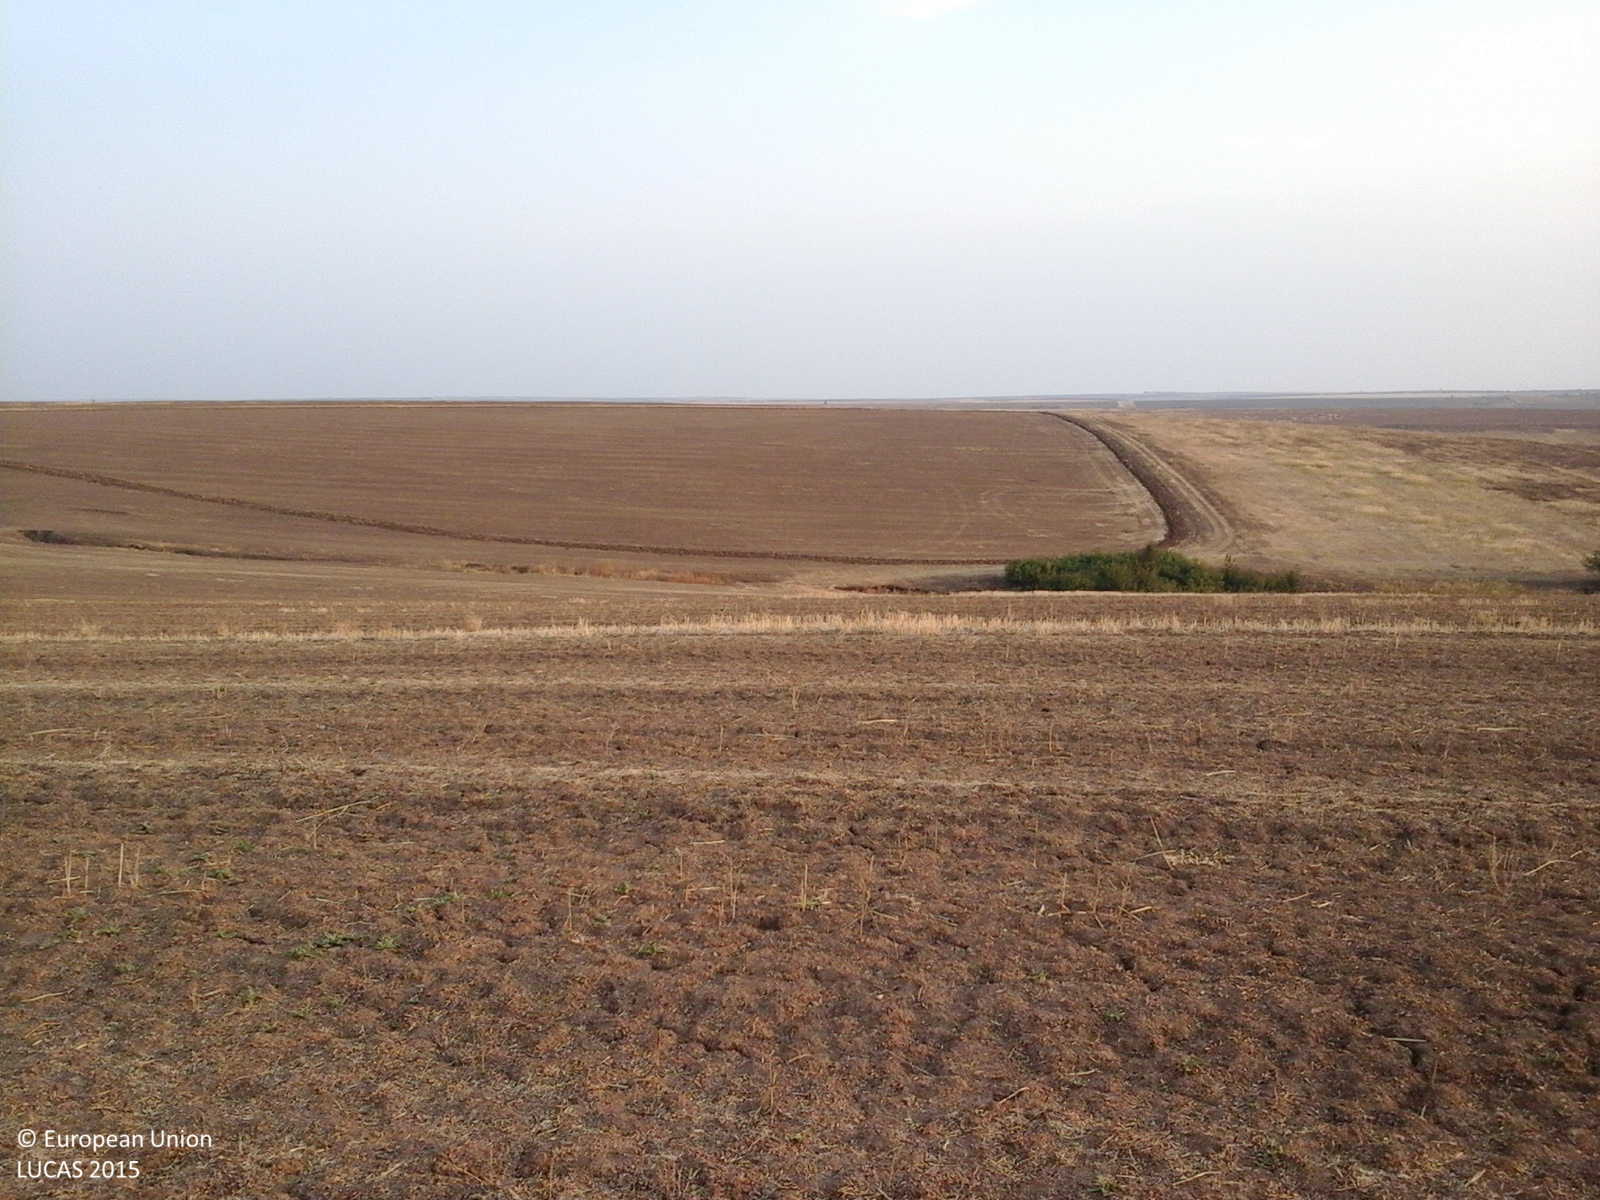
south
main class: Cropland
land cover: Common wheat
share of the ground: < 10 %
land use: Agriculture (excluding fallow land and kitchen gardens)
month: August
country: RO
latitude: 44.4143
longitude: 23.0691
